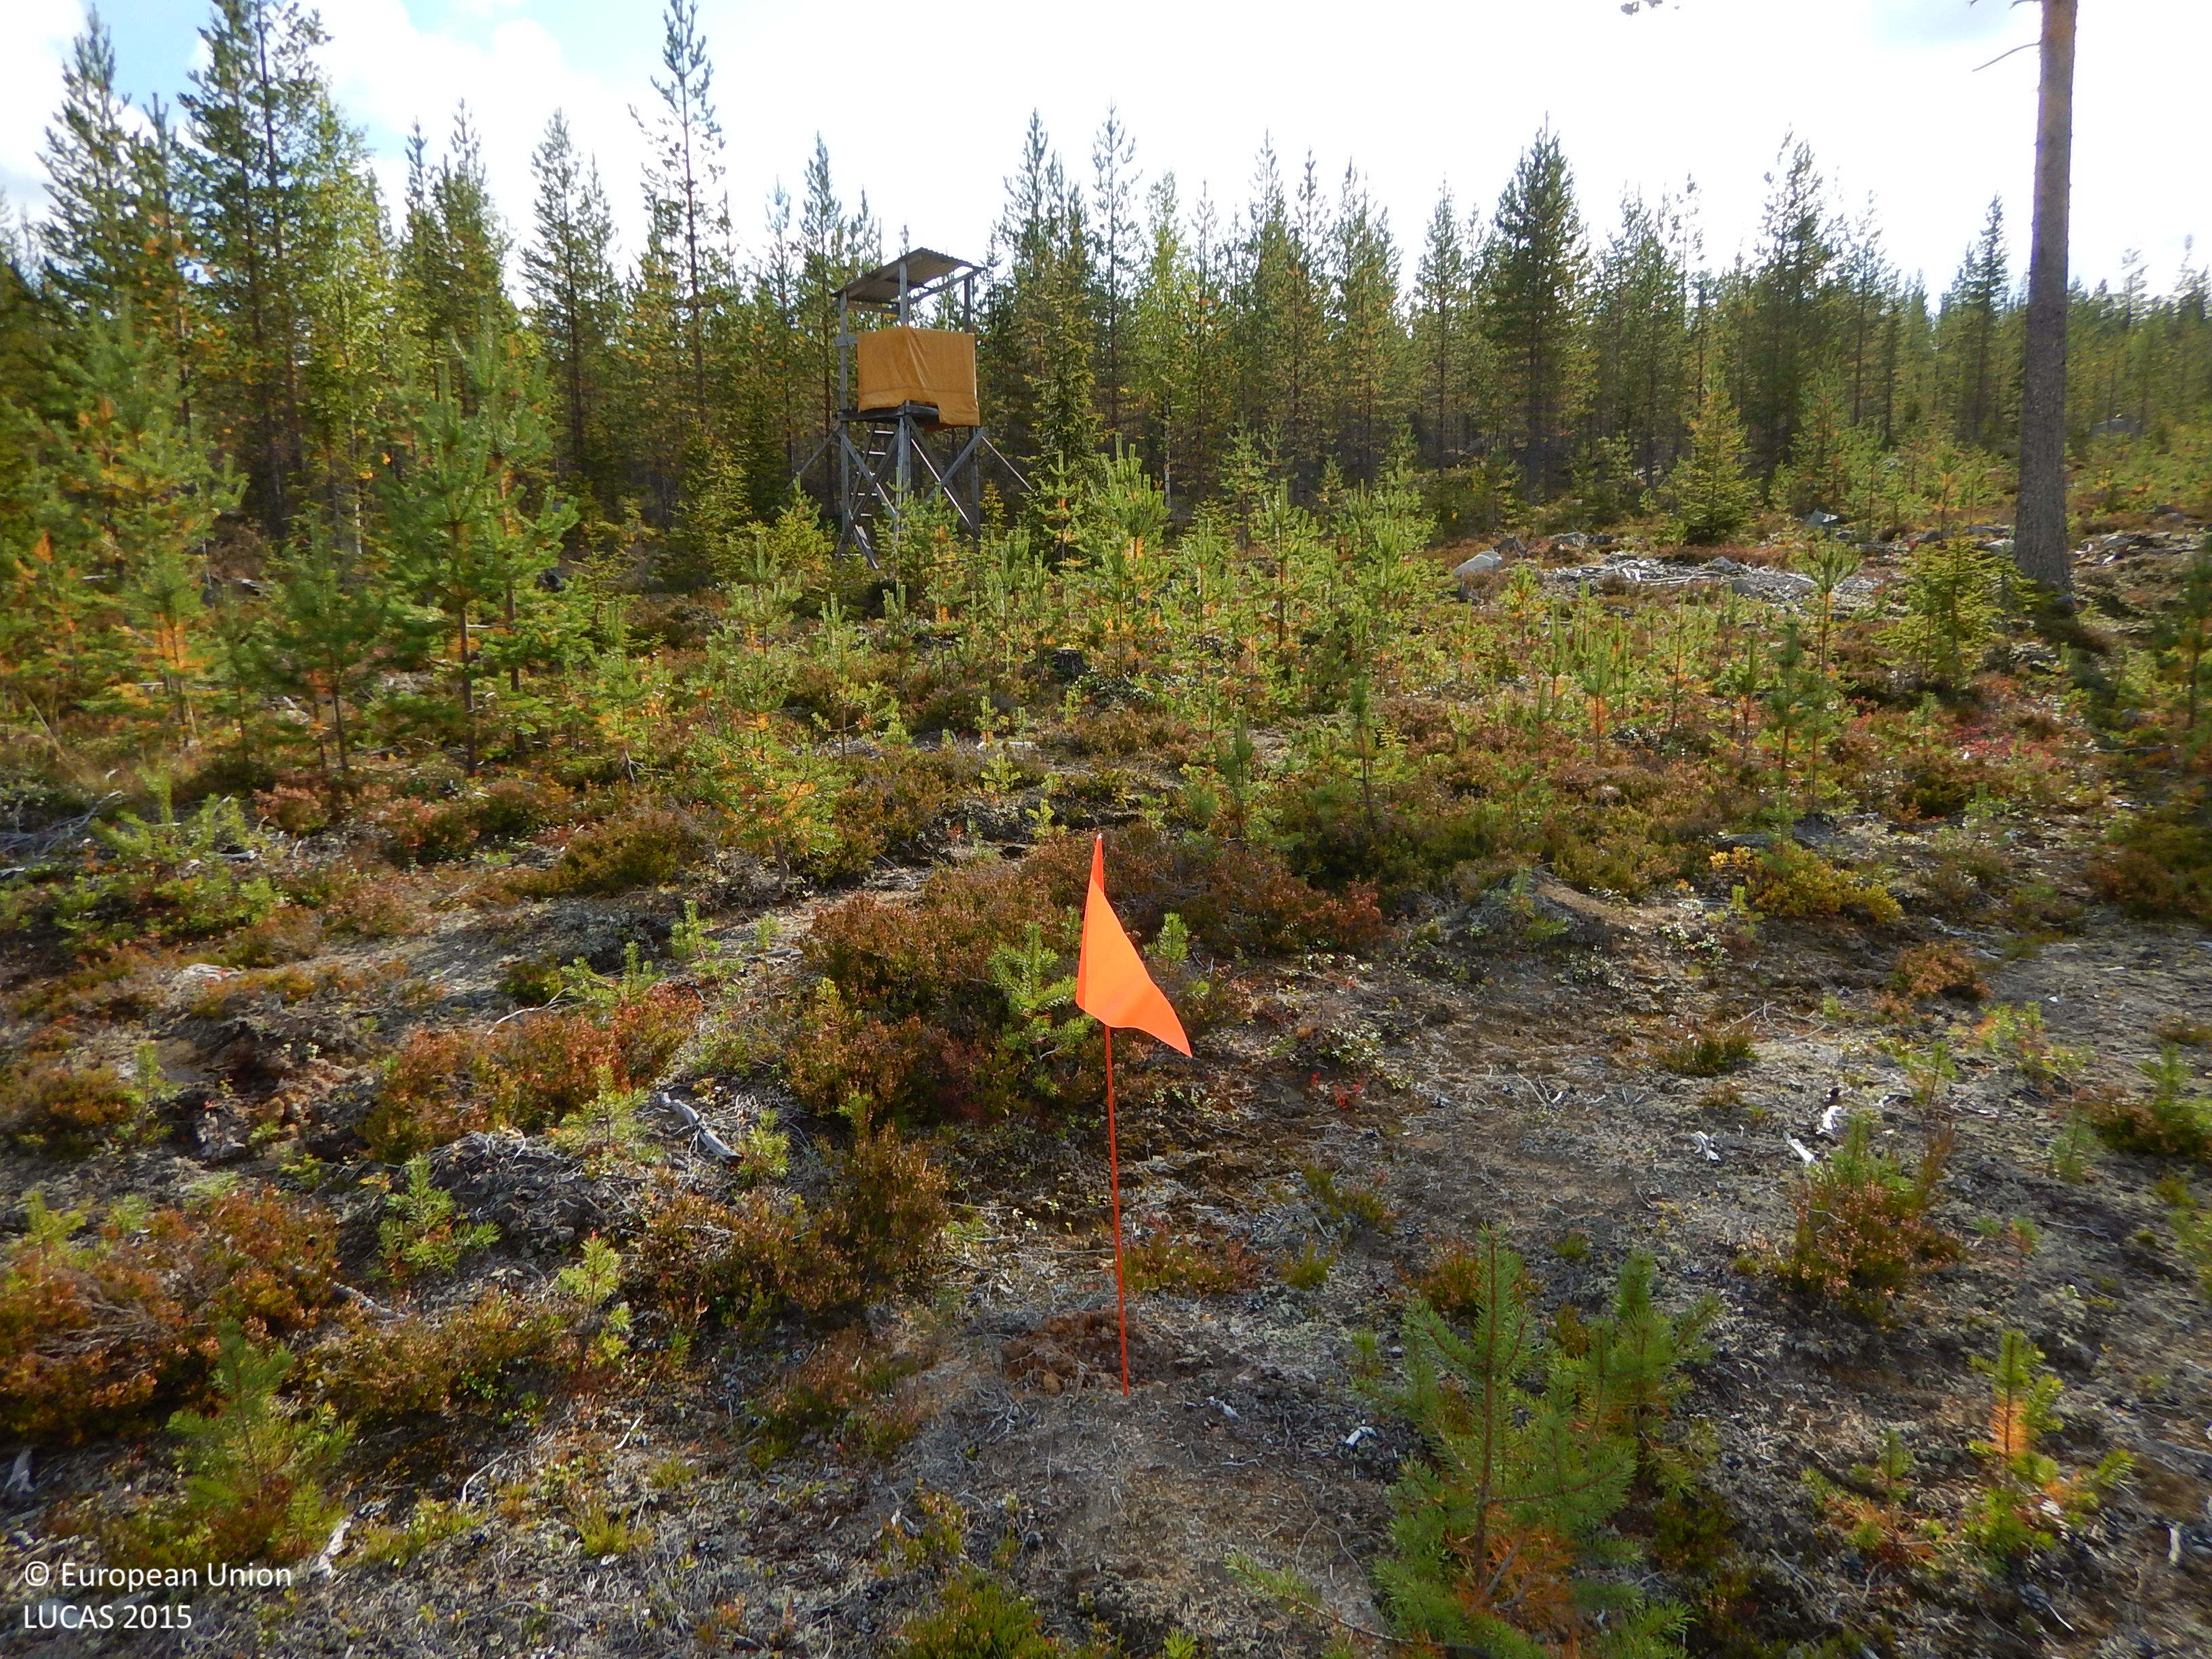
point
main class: Woodland
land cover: Pine dominated coniferous woodland
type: boreal forest
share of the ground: 10 - 25 %
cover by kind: shrubs 30 %, lichens and mosses 25 %, herbaceous plants 20 %, unconsolidated bare surface 15 %, coniferous forest trees 10 %
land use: Forestry
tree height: < 5 m
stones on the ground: < 10 %
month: September
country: SE
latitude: 64.8203
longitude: 20.1464
